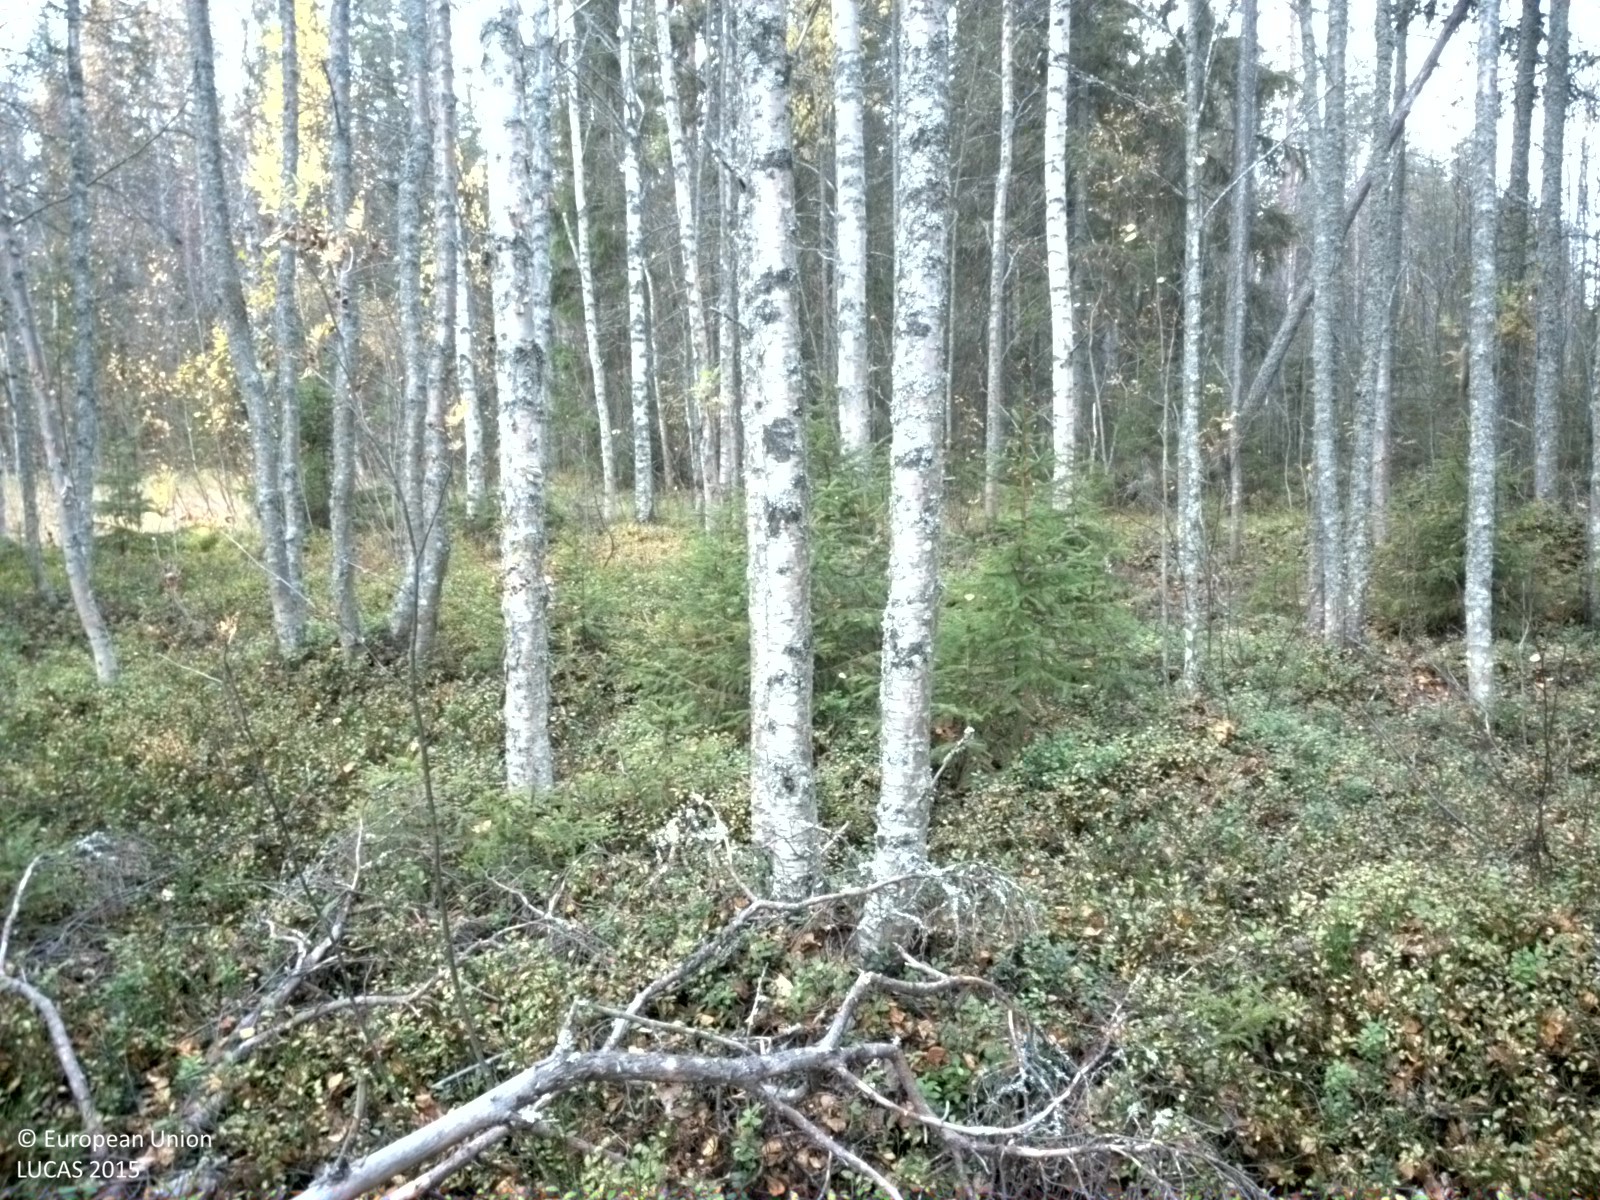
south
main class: Woodland
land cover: Spruce dominated mixed woodland
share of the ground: 25 - 50 %
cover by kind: shrubs 50 %, broadleaved forest trees 30 %, coniferous forest trees 20 %
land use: Forestry
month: October
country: SE
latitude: 65.6340
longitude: 21.9022
